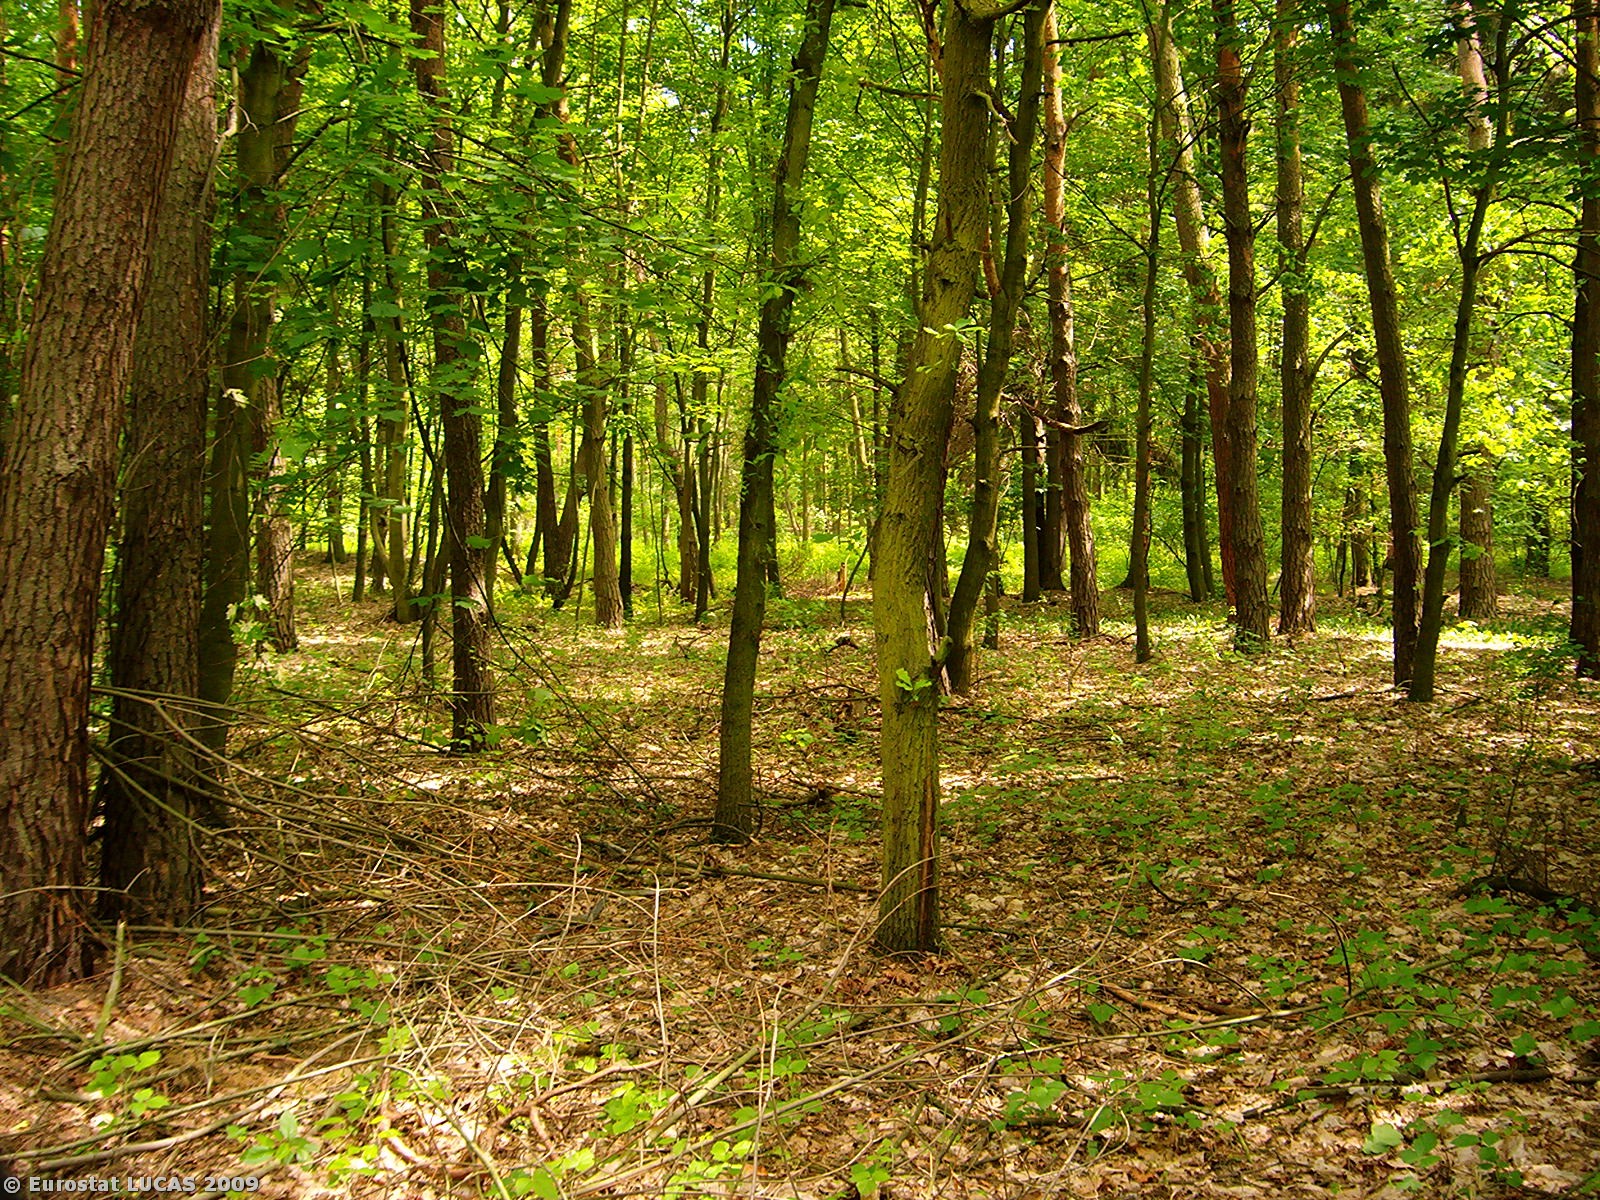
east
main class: Woodland
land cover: Mixed woodland
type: hemiboreal forest and nemoral coniferous forest and mixed broadleaved-coniferous forest
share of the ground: > 75 %
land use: Forestry
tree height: > 5 m
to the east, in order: Mixed woodland; Grass margins; Triticale
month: May
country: PL
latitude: 52.5327
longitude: 16.9825
